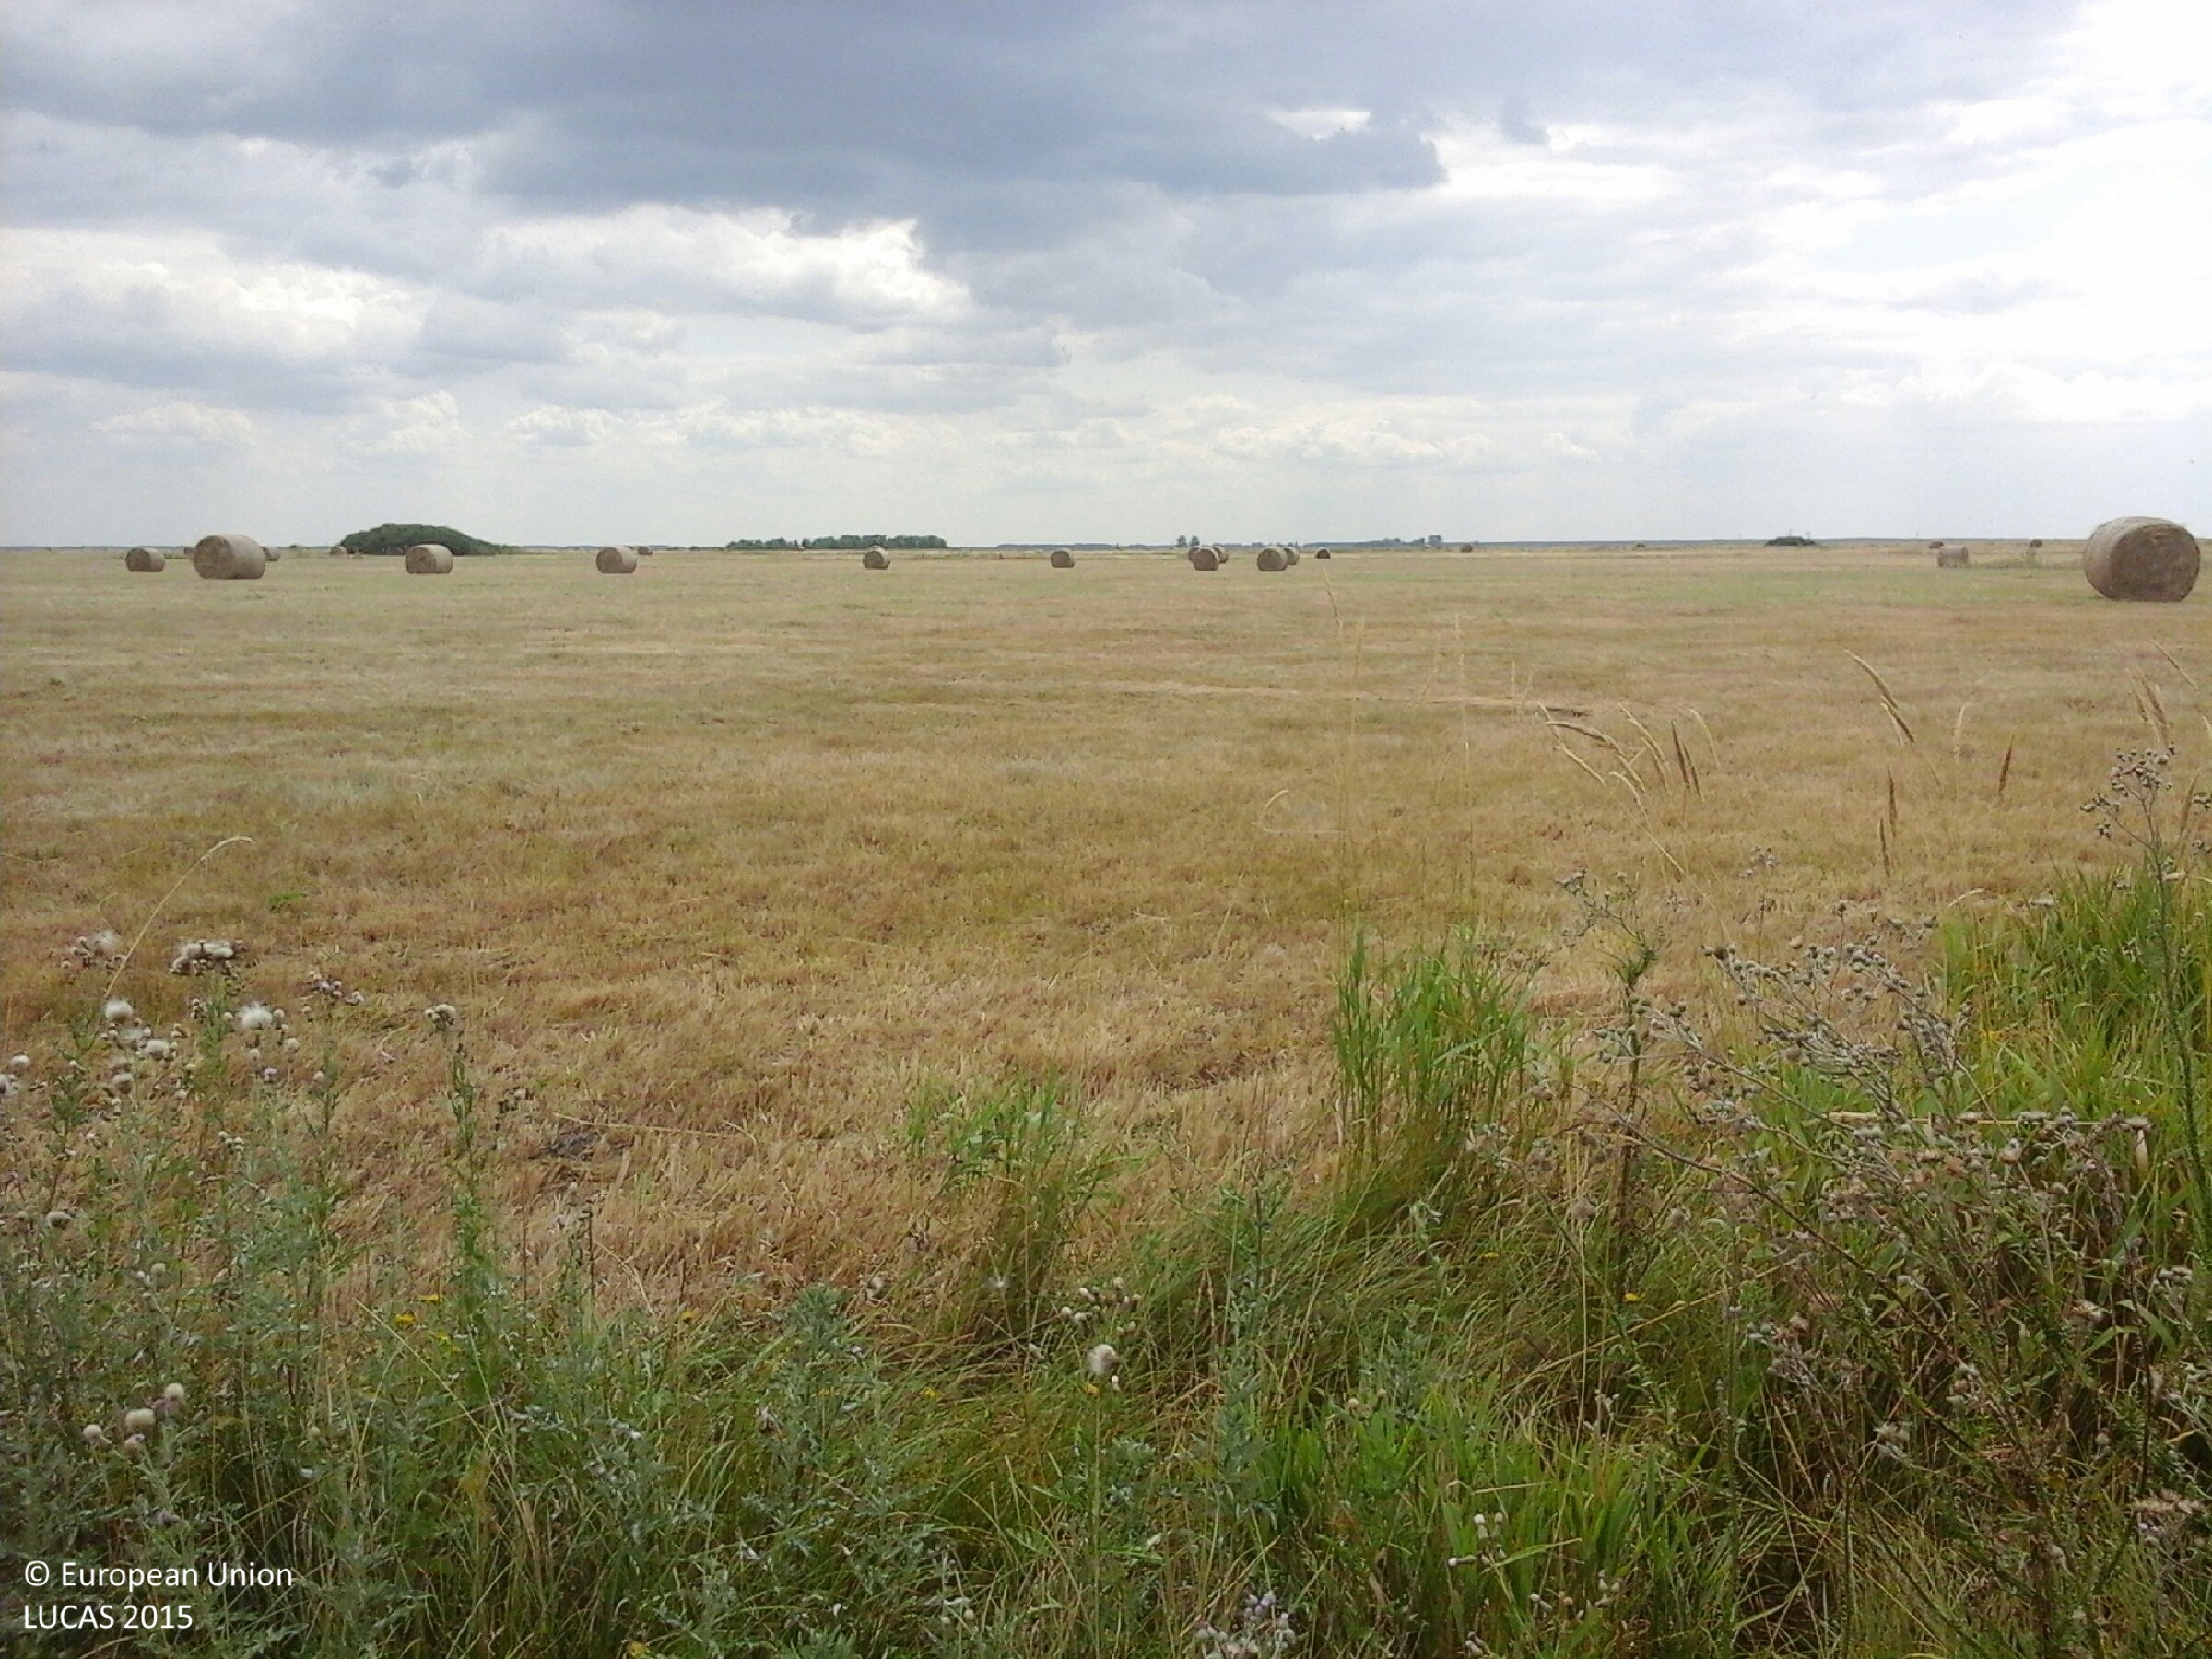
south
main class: Grassland
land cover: Grassland without tree/shrub cover
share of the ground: > 75 %
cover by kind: herbaceous plants 100 %
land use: Agriculture (excluding fallow land and kitchen gardens)
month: July
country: HU
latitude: 47.7788
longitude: 20.8327
